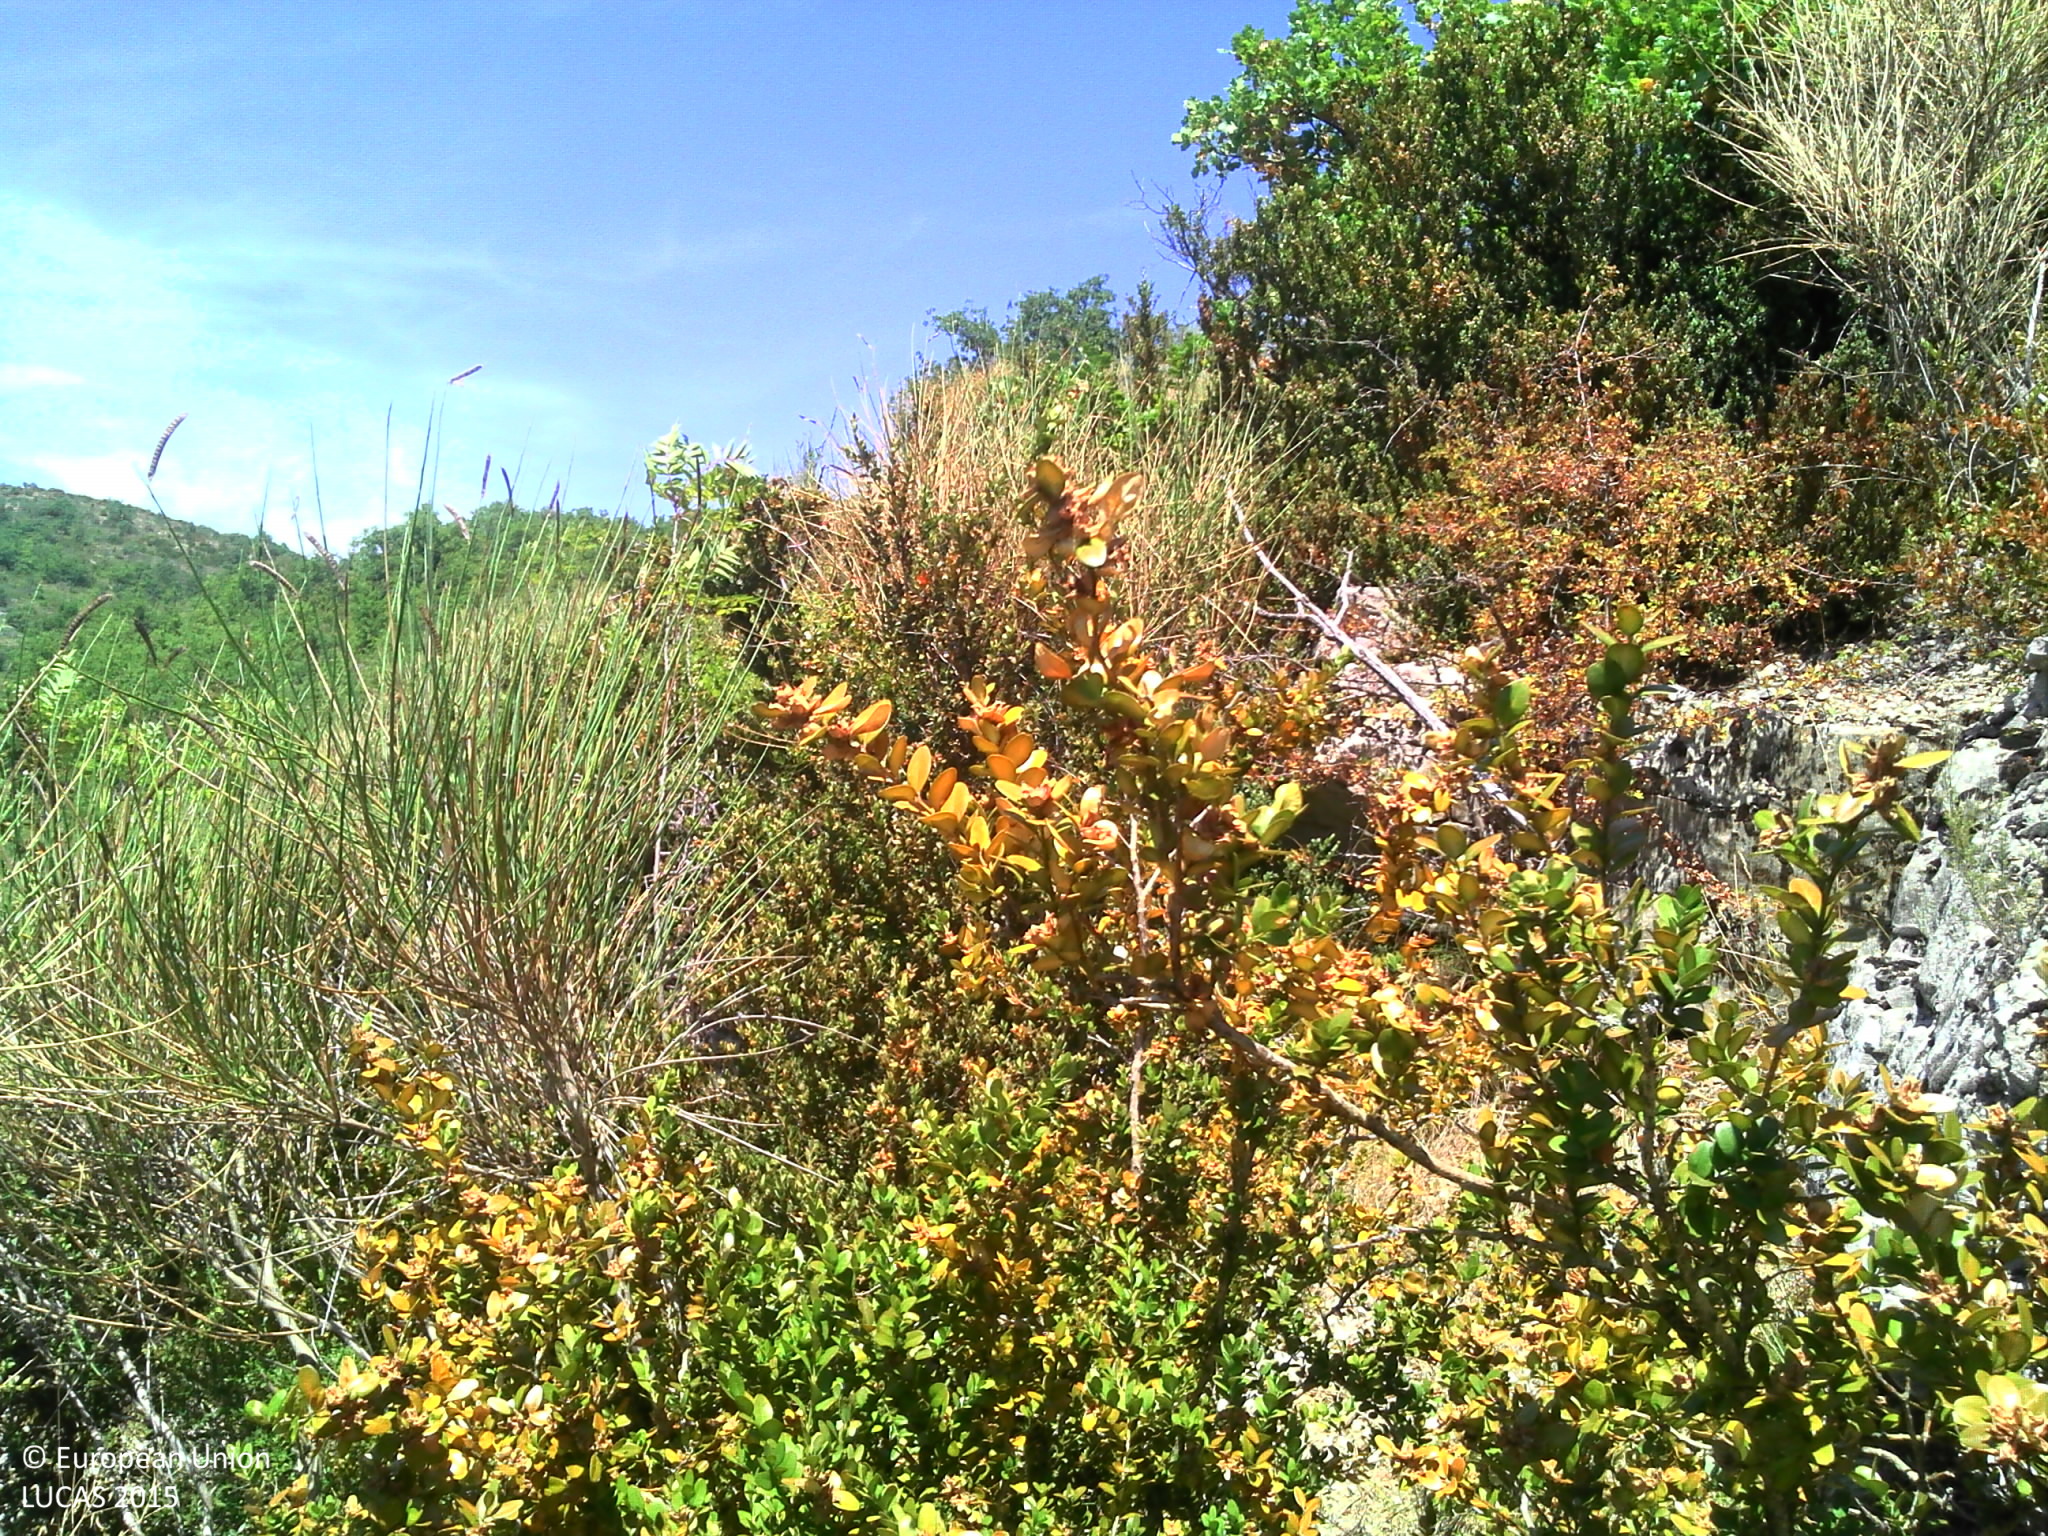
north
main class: Shrubland
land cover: Shrubland with sparse tree cover
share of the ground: > 75 %
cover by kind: shrubs 90 %, broadleaved forest trees 5 %, unconsolidated bare surface 5 %
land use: Semi-natural and natural areas not in use
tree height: < 5 m
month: July
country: FR
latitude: 44.7180
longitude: 4.6409
